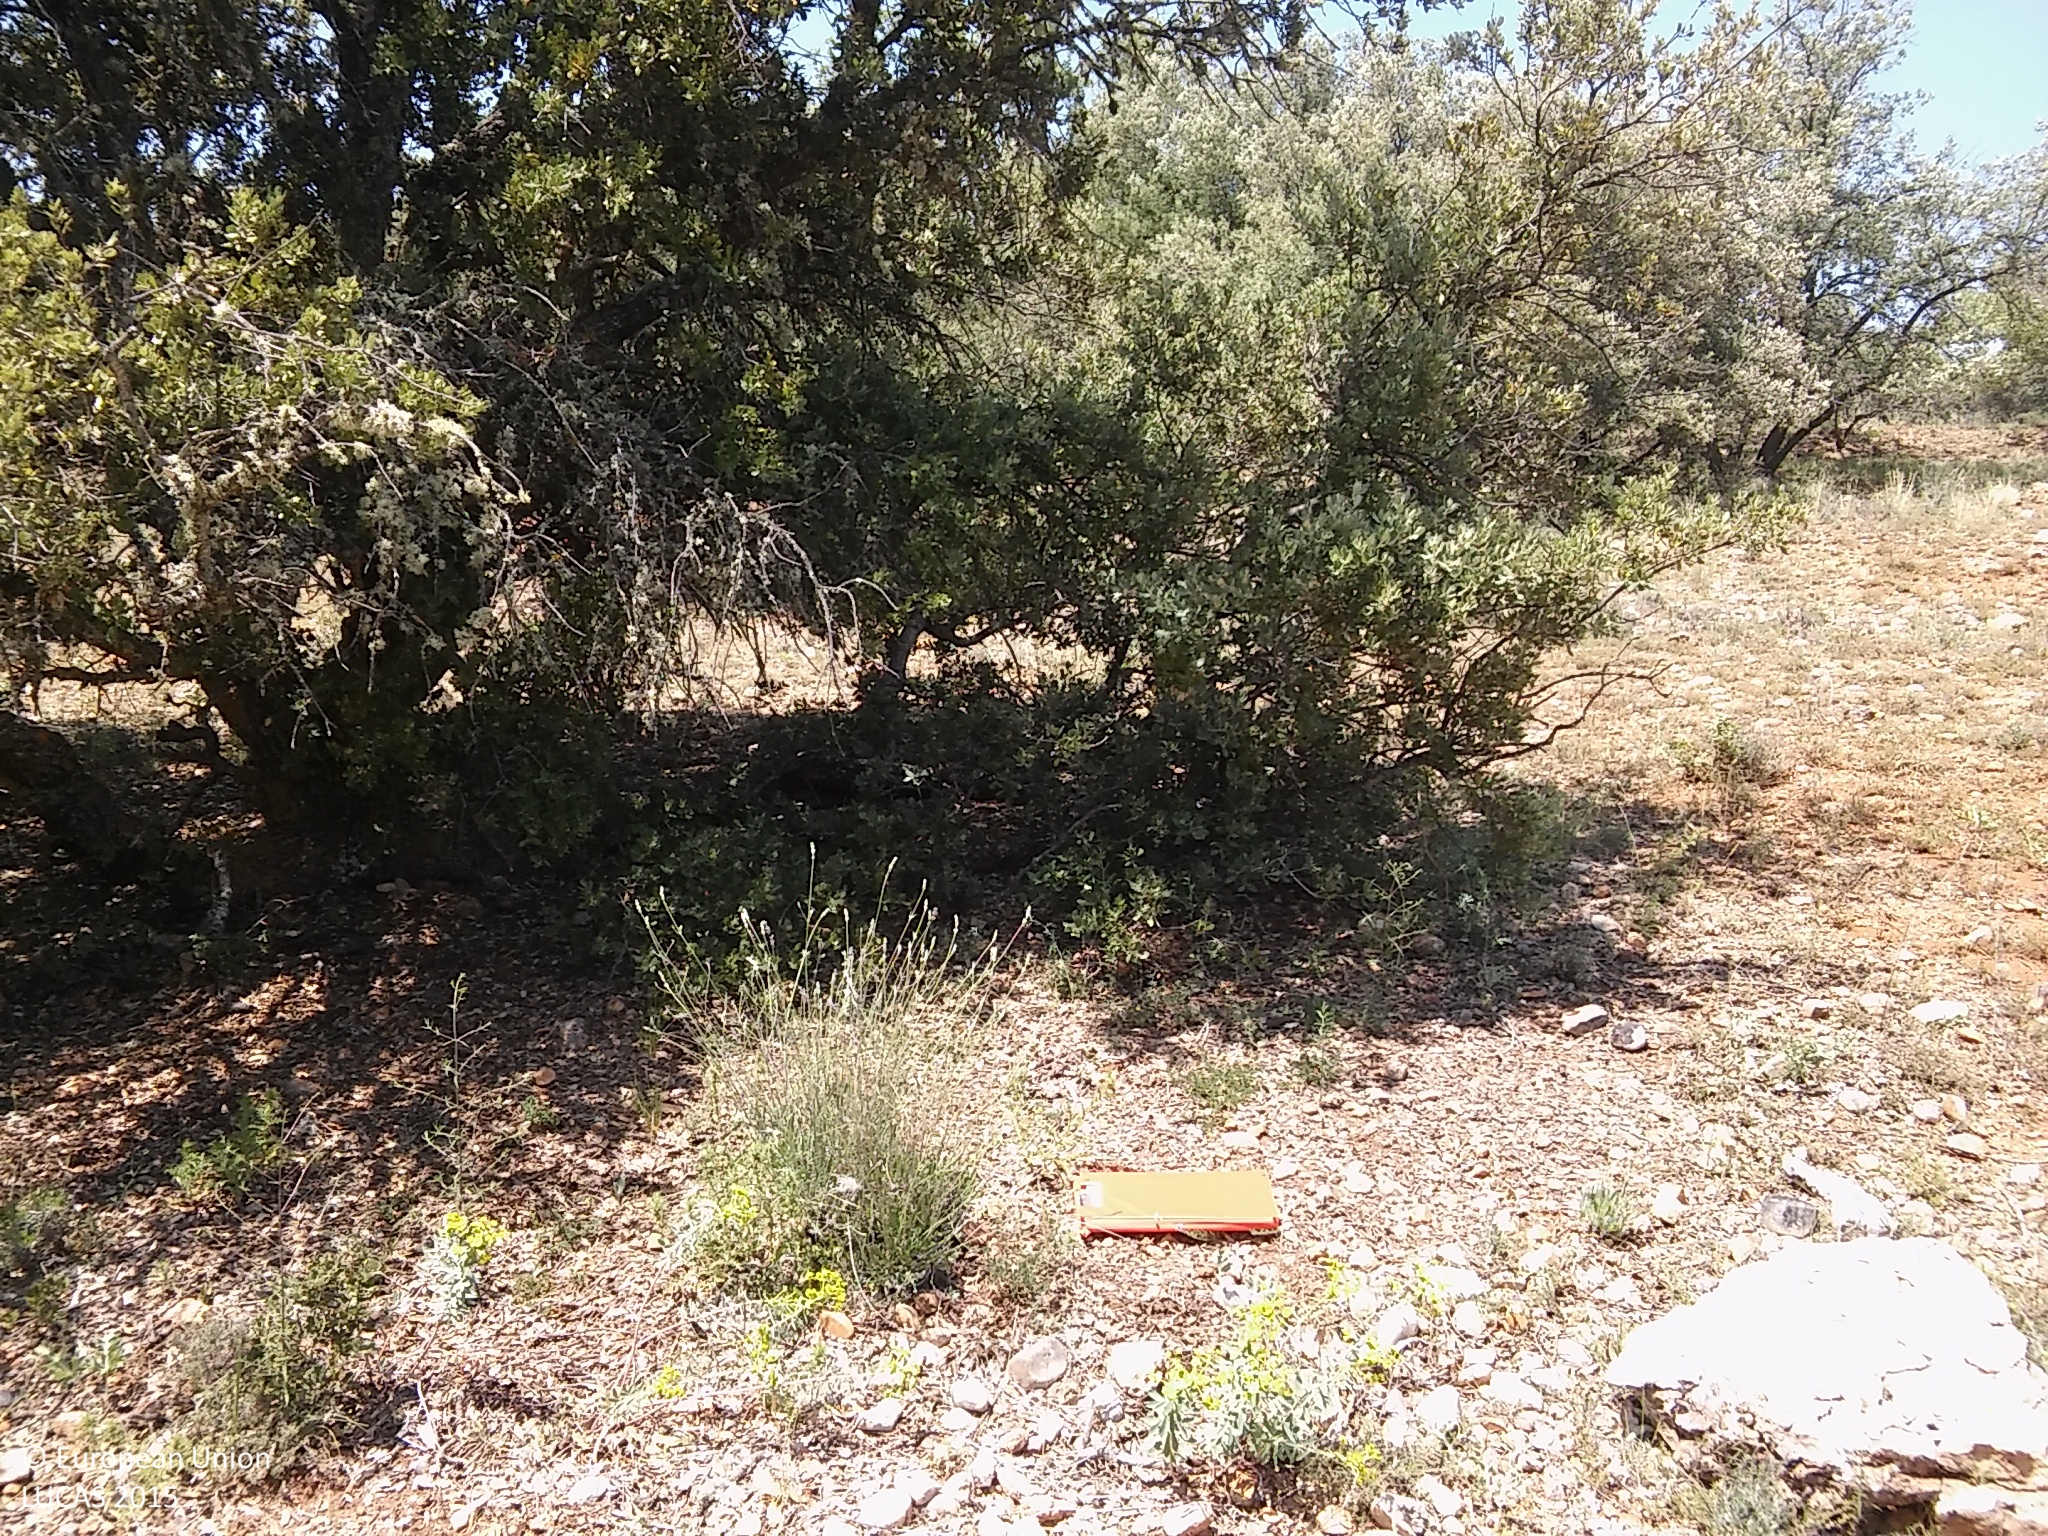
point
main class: Woodland
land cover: Broadleaved woodland
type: broadleaved evergreen forest
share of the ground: 25 - 50 %
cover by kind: unconsolidated bare surface 40 %, broadleaved forest trees 30 %, shrubs 20 %, herbaceous plants 10 %
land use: Forestry
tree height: > 5 m
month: July
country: ES
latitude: 41.4978
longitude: -3.5735
